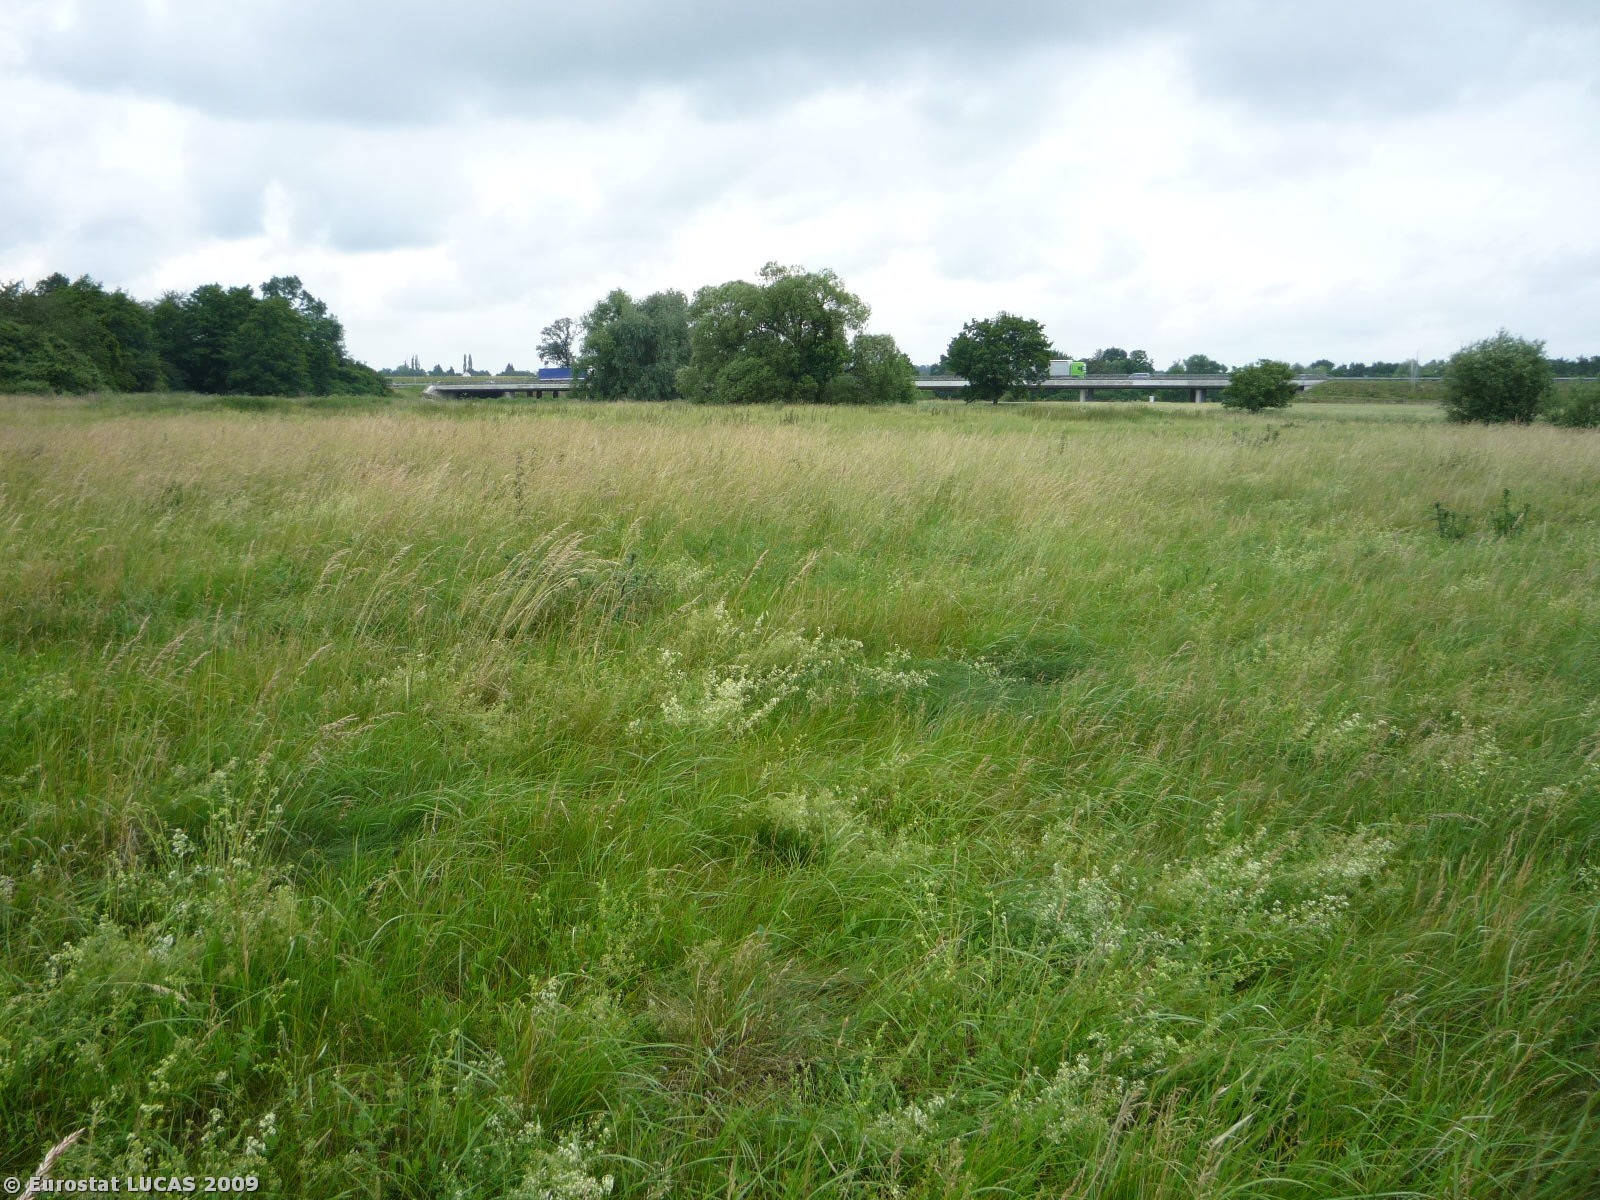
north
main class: Grassland
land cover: Grassland without tree/shrub cover
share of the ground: > 75 %
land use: Agriculture (excluding fallow land and kitchen gardens)
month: June
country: CZ
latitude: 50.1263
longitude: 15.4452
